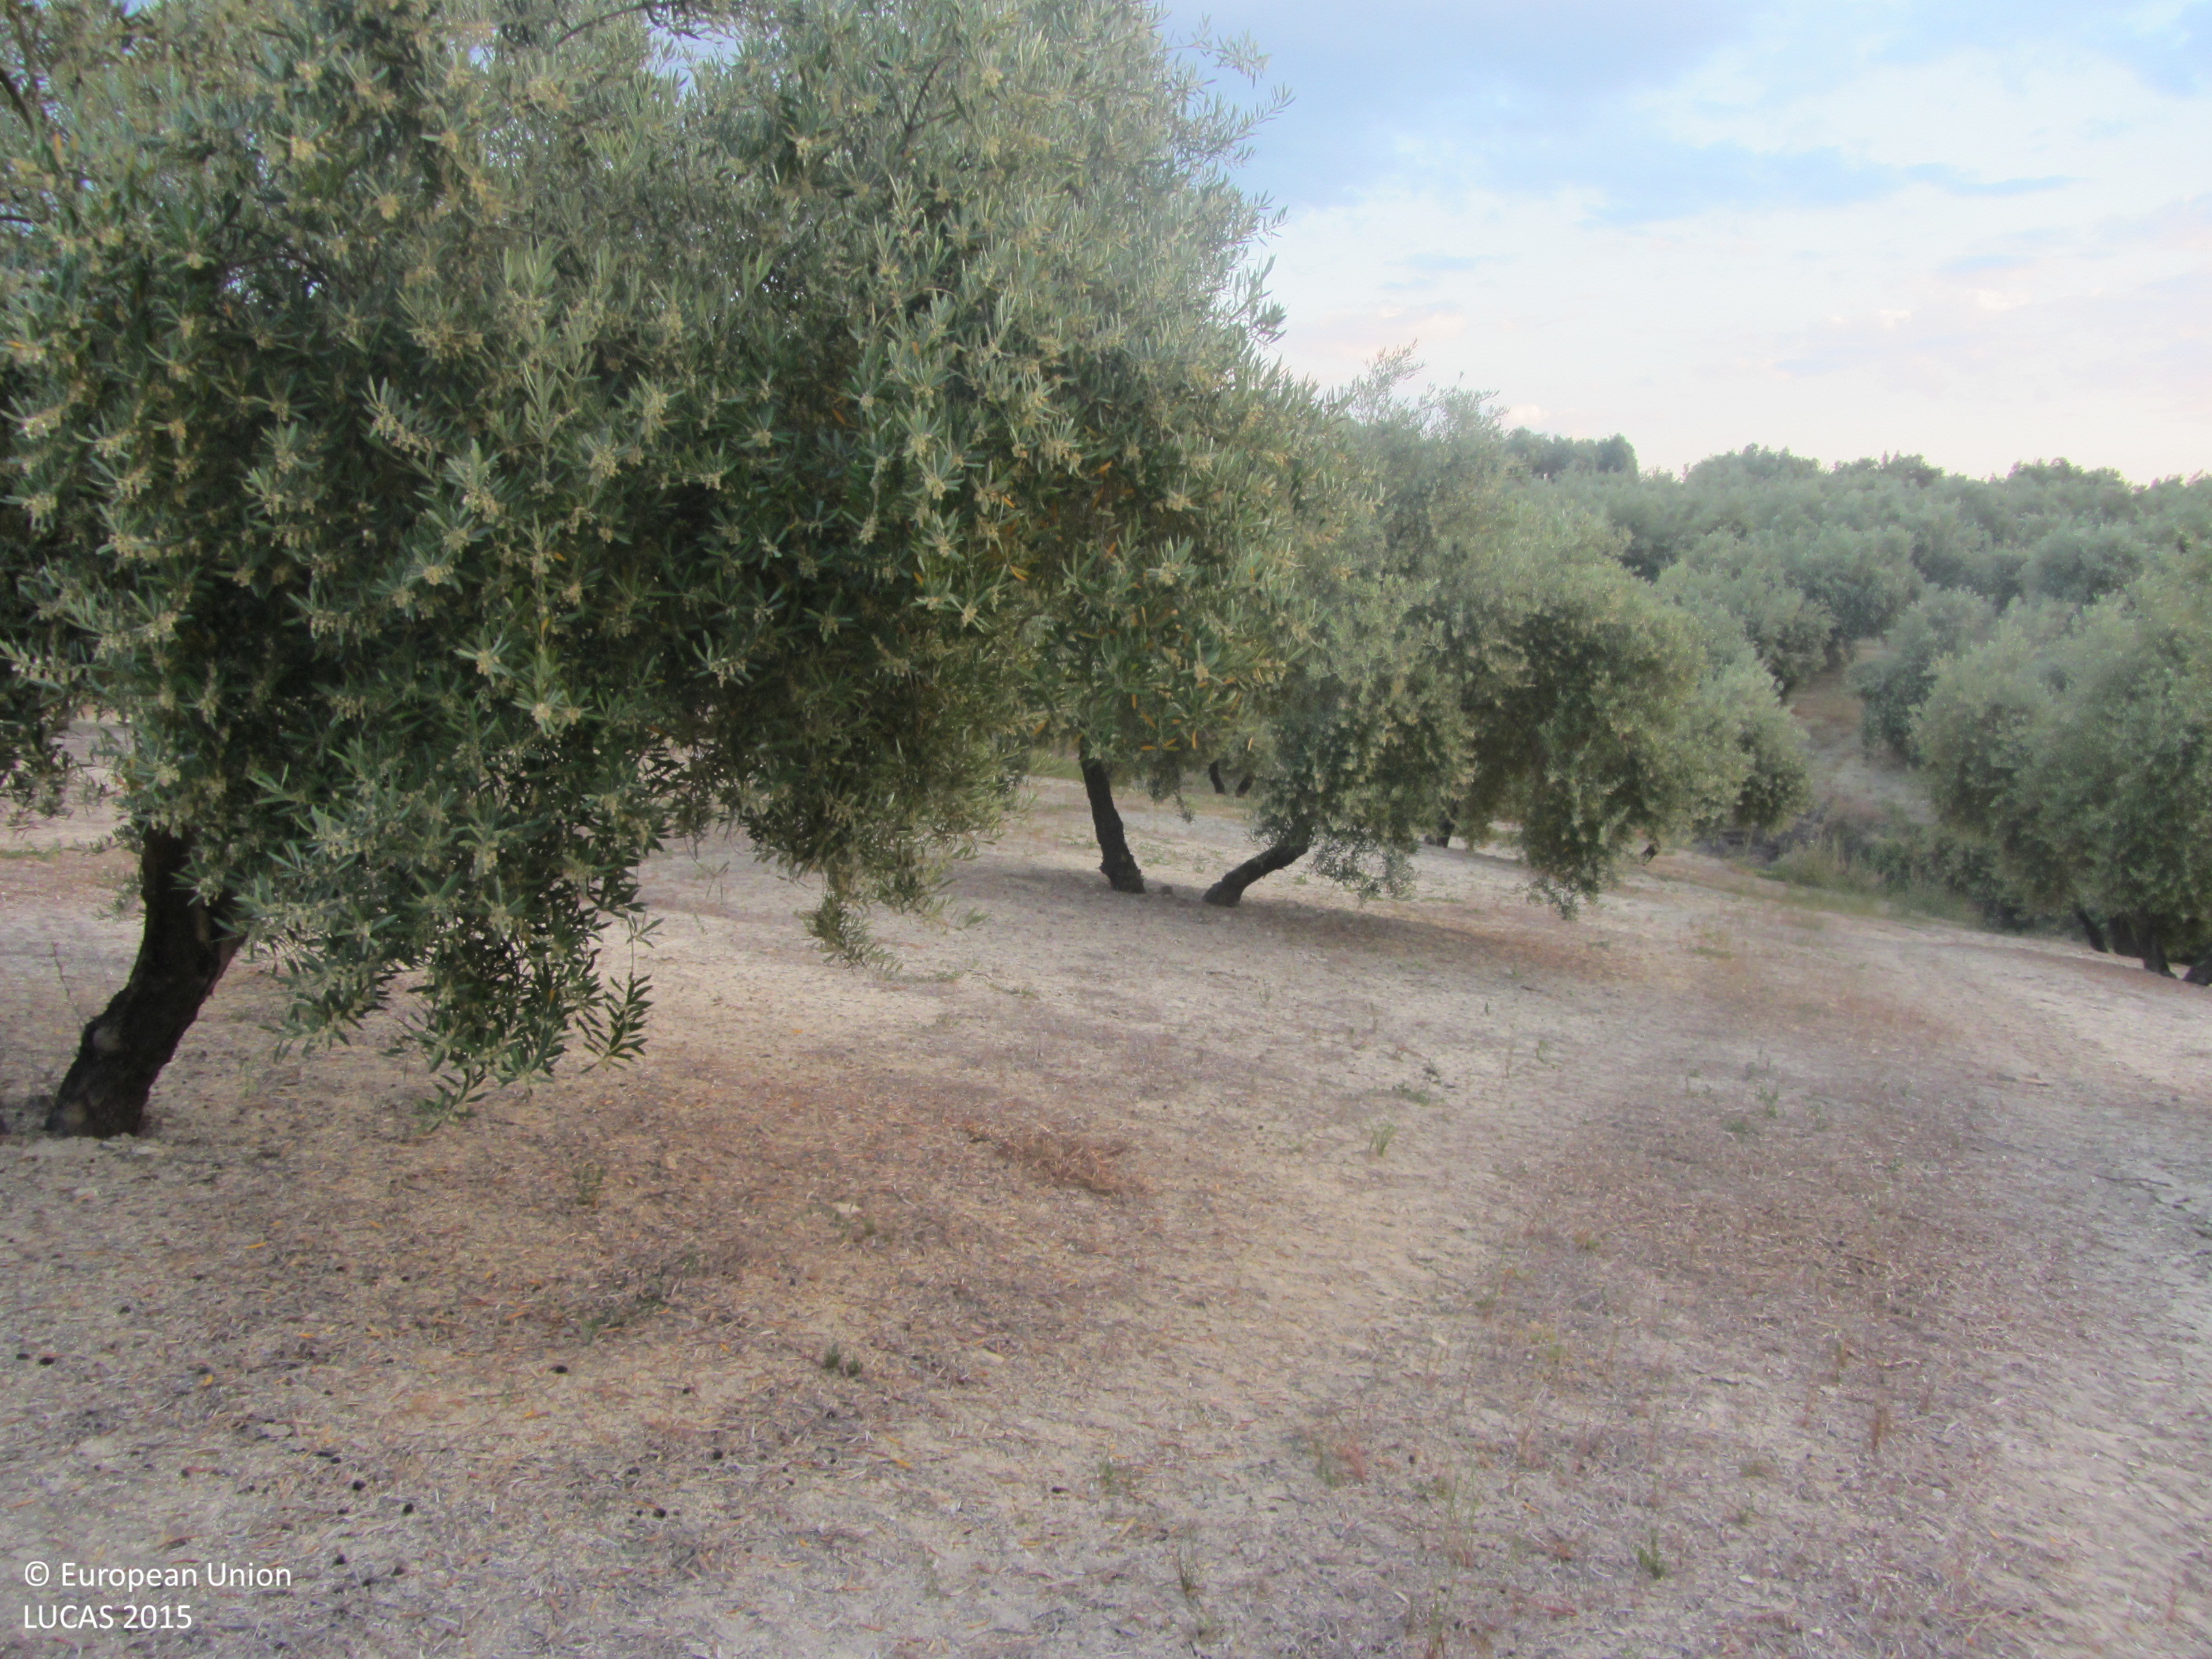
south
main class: Cropland
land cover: Olive groves
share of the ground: 25 - 50 %
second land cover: Other bare soil
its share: > 75 %
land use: Agriculture (excluding fallow land and kitchen gardens)
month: May
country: ES
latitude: 38.1651
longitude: -3.0449
